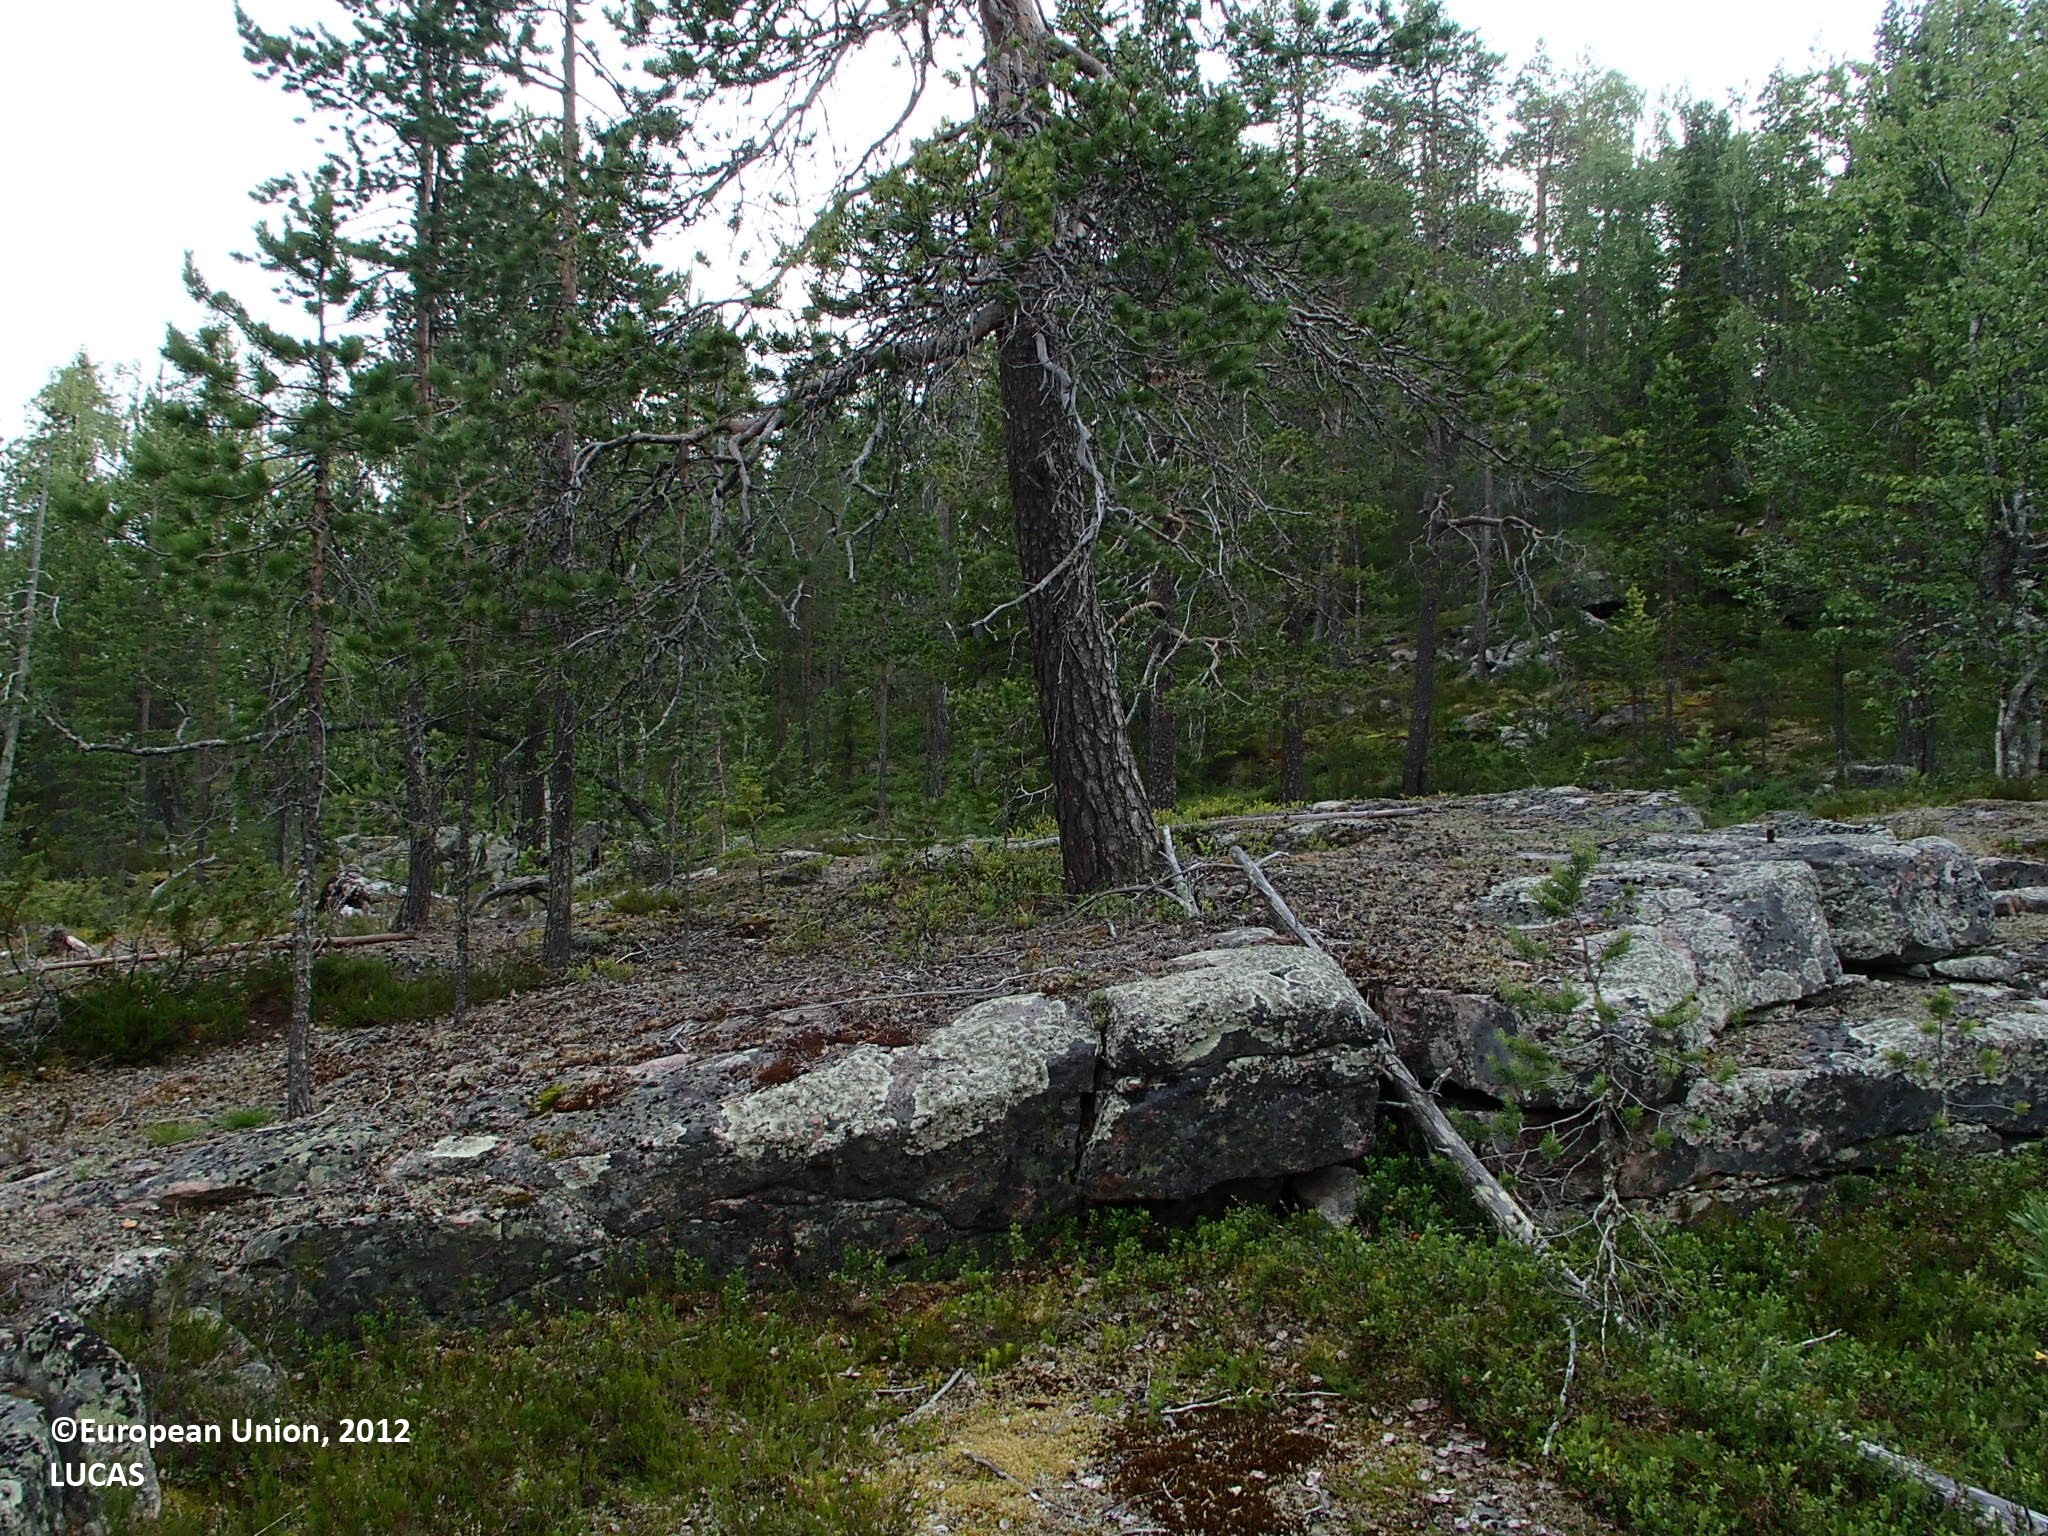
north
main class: Woodland
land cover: Other mixed woodland
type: boreal forest
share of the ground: 25 - 50 %
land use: Forestry
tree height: > 5 m
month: July
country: FI
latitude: 66.6217
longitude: 25.5792
